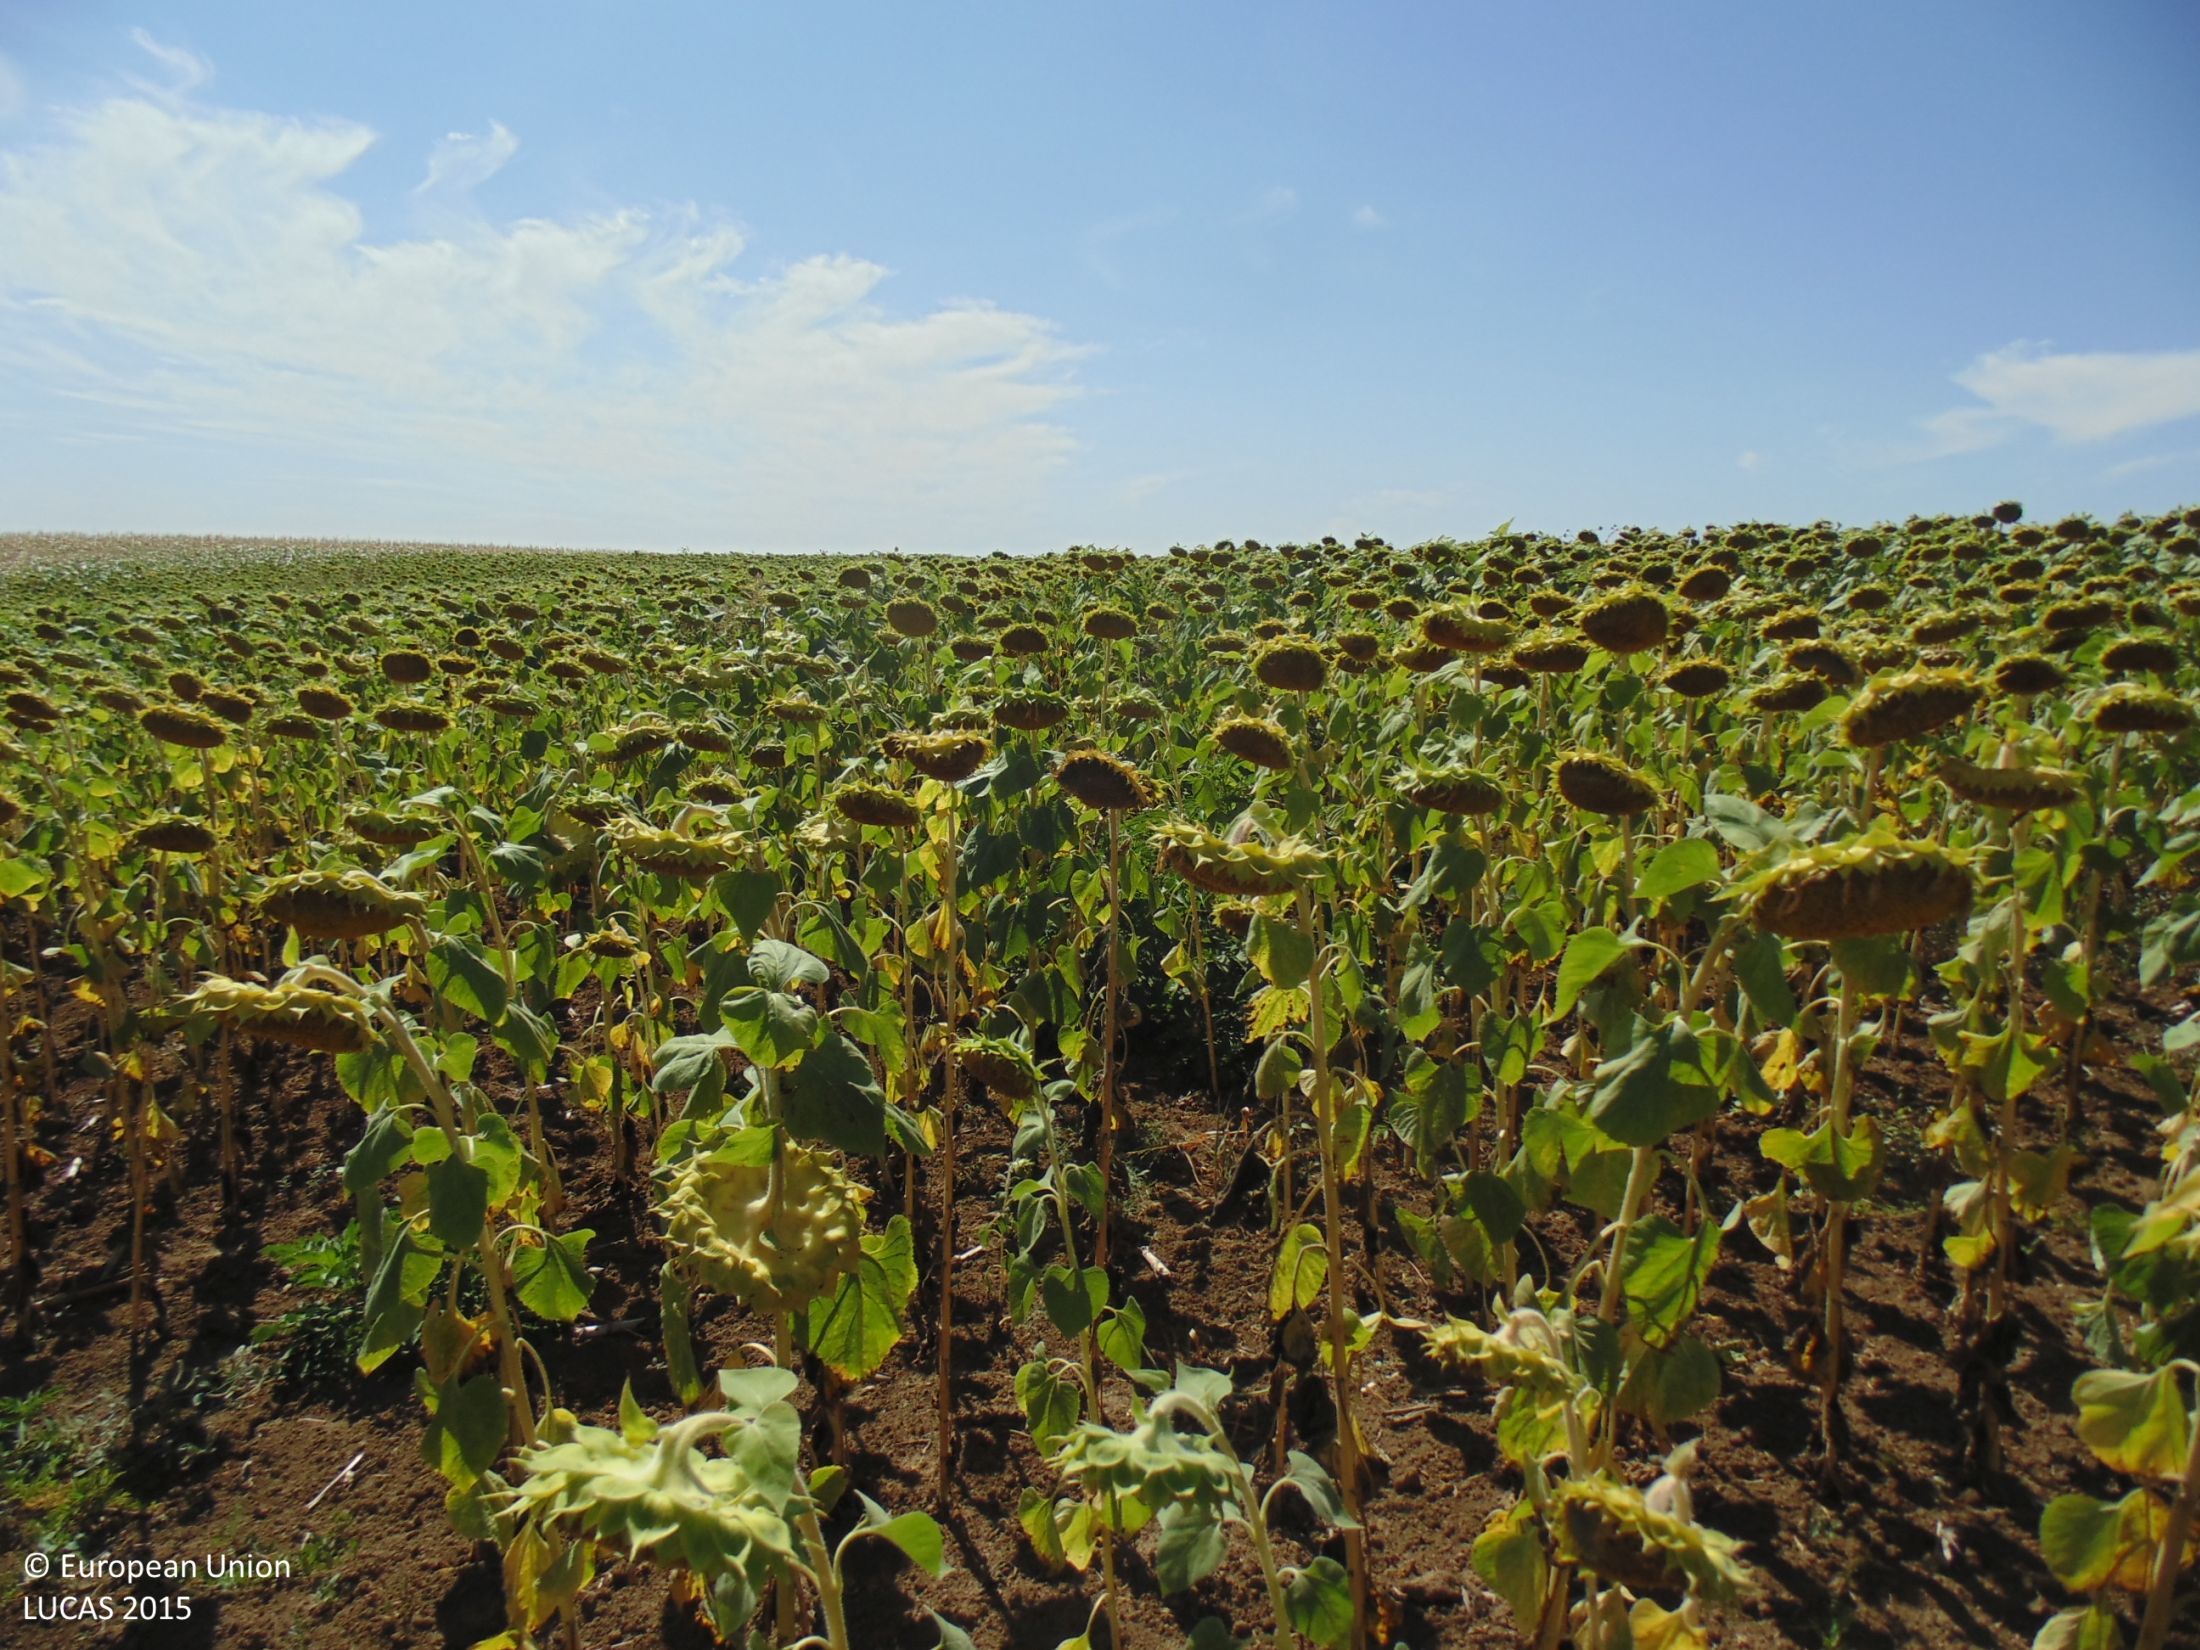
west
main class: Cropland
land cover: Sunflower
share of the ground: > 75 %
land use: Agriculture (excluding fallow land and kitchen gardens)
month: August
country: BG
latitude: 43.8433
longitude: 27.7167
